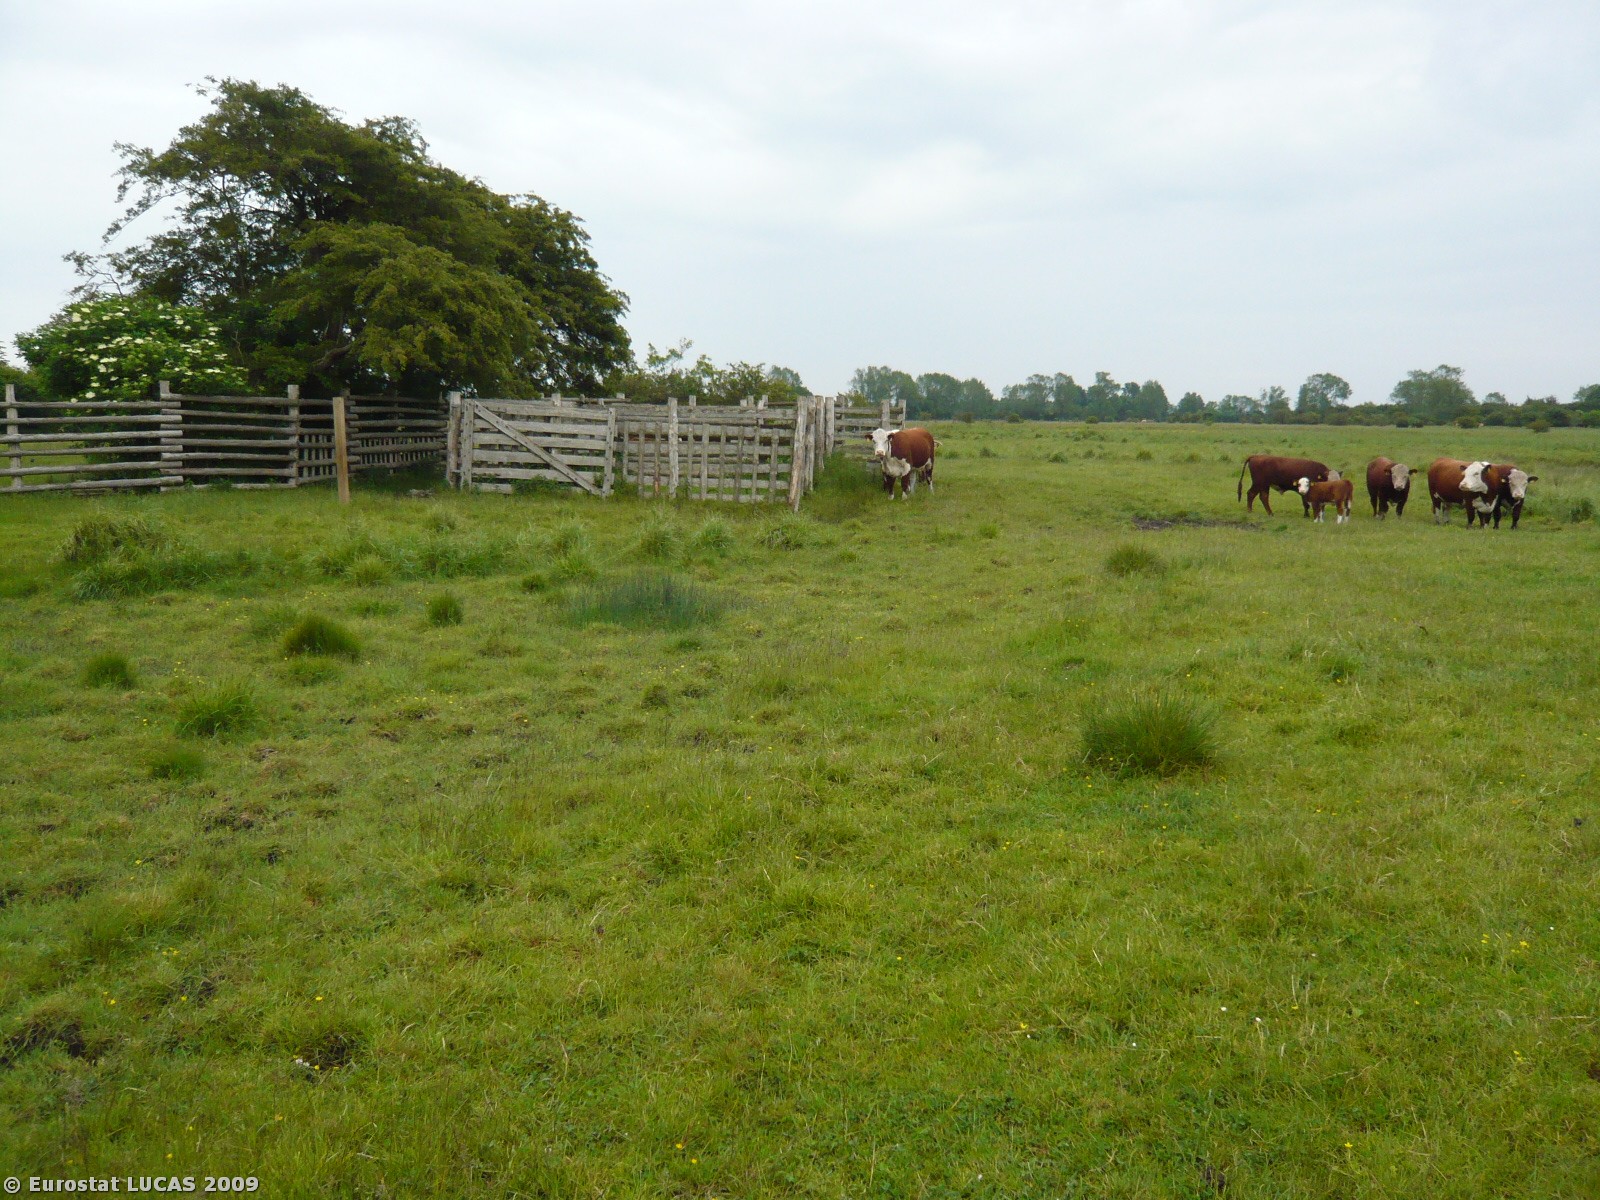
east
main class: Grassland
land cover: Grassland without tree/shrub cover
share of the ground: > 75 %
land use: Agriculture (excluding fallow land and kitchen gardens)
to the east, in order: Grassland without tree/shrub cover; Fences; Shrubland with sparse tree cover; Grassland without tree/shrub cover; Fences; Ditches and canals; Grassland without tree/shrub cover; Fences; Ditches and canals; Grassland without tree/shrub cover
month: June
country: DK
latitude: 54.7366
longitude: 11.8160
